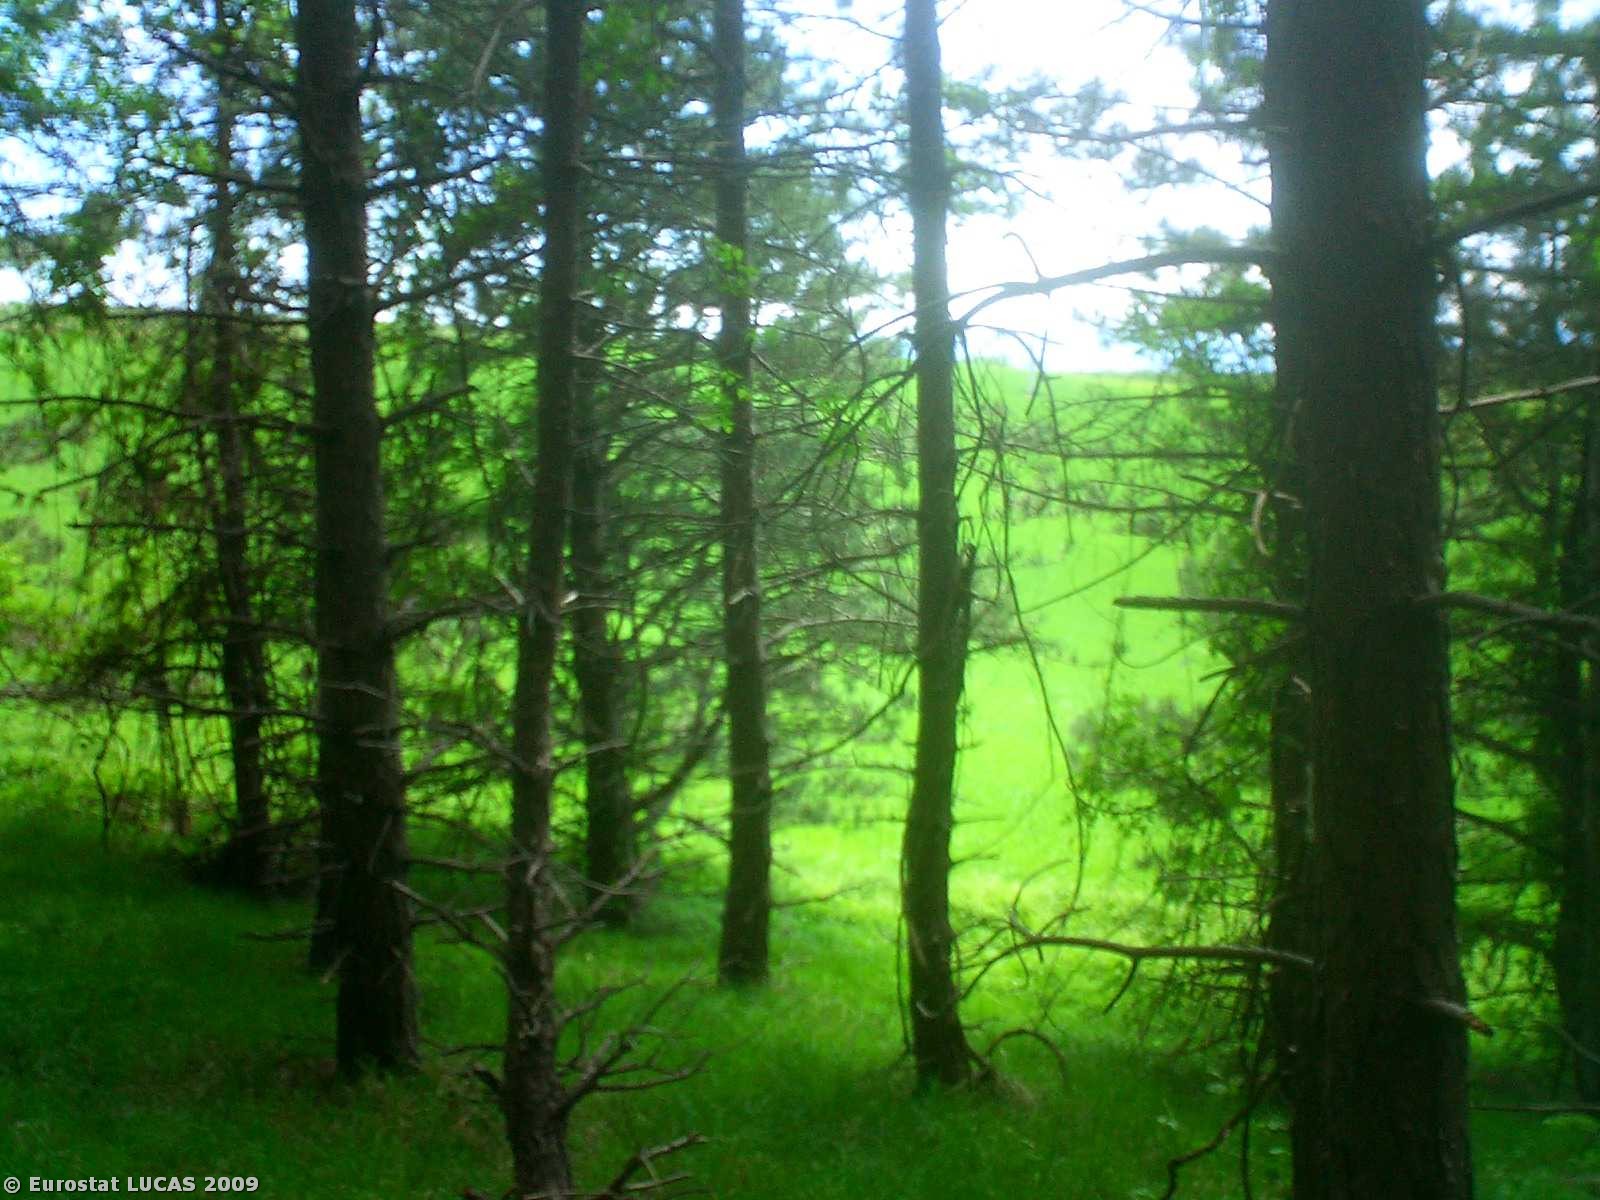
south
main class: Woodland
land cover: Coniferous woodland
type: alpine coniferous forest
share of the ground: 50 - 75 %
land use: Forestry
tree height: > 5 m
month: May
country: IT
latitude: 44.1392
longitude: 11.6337
